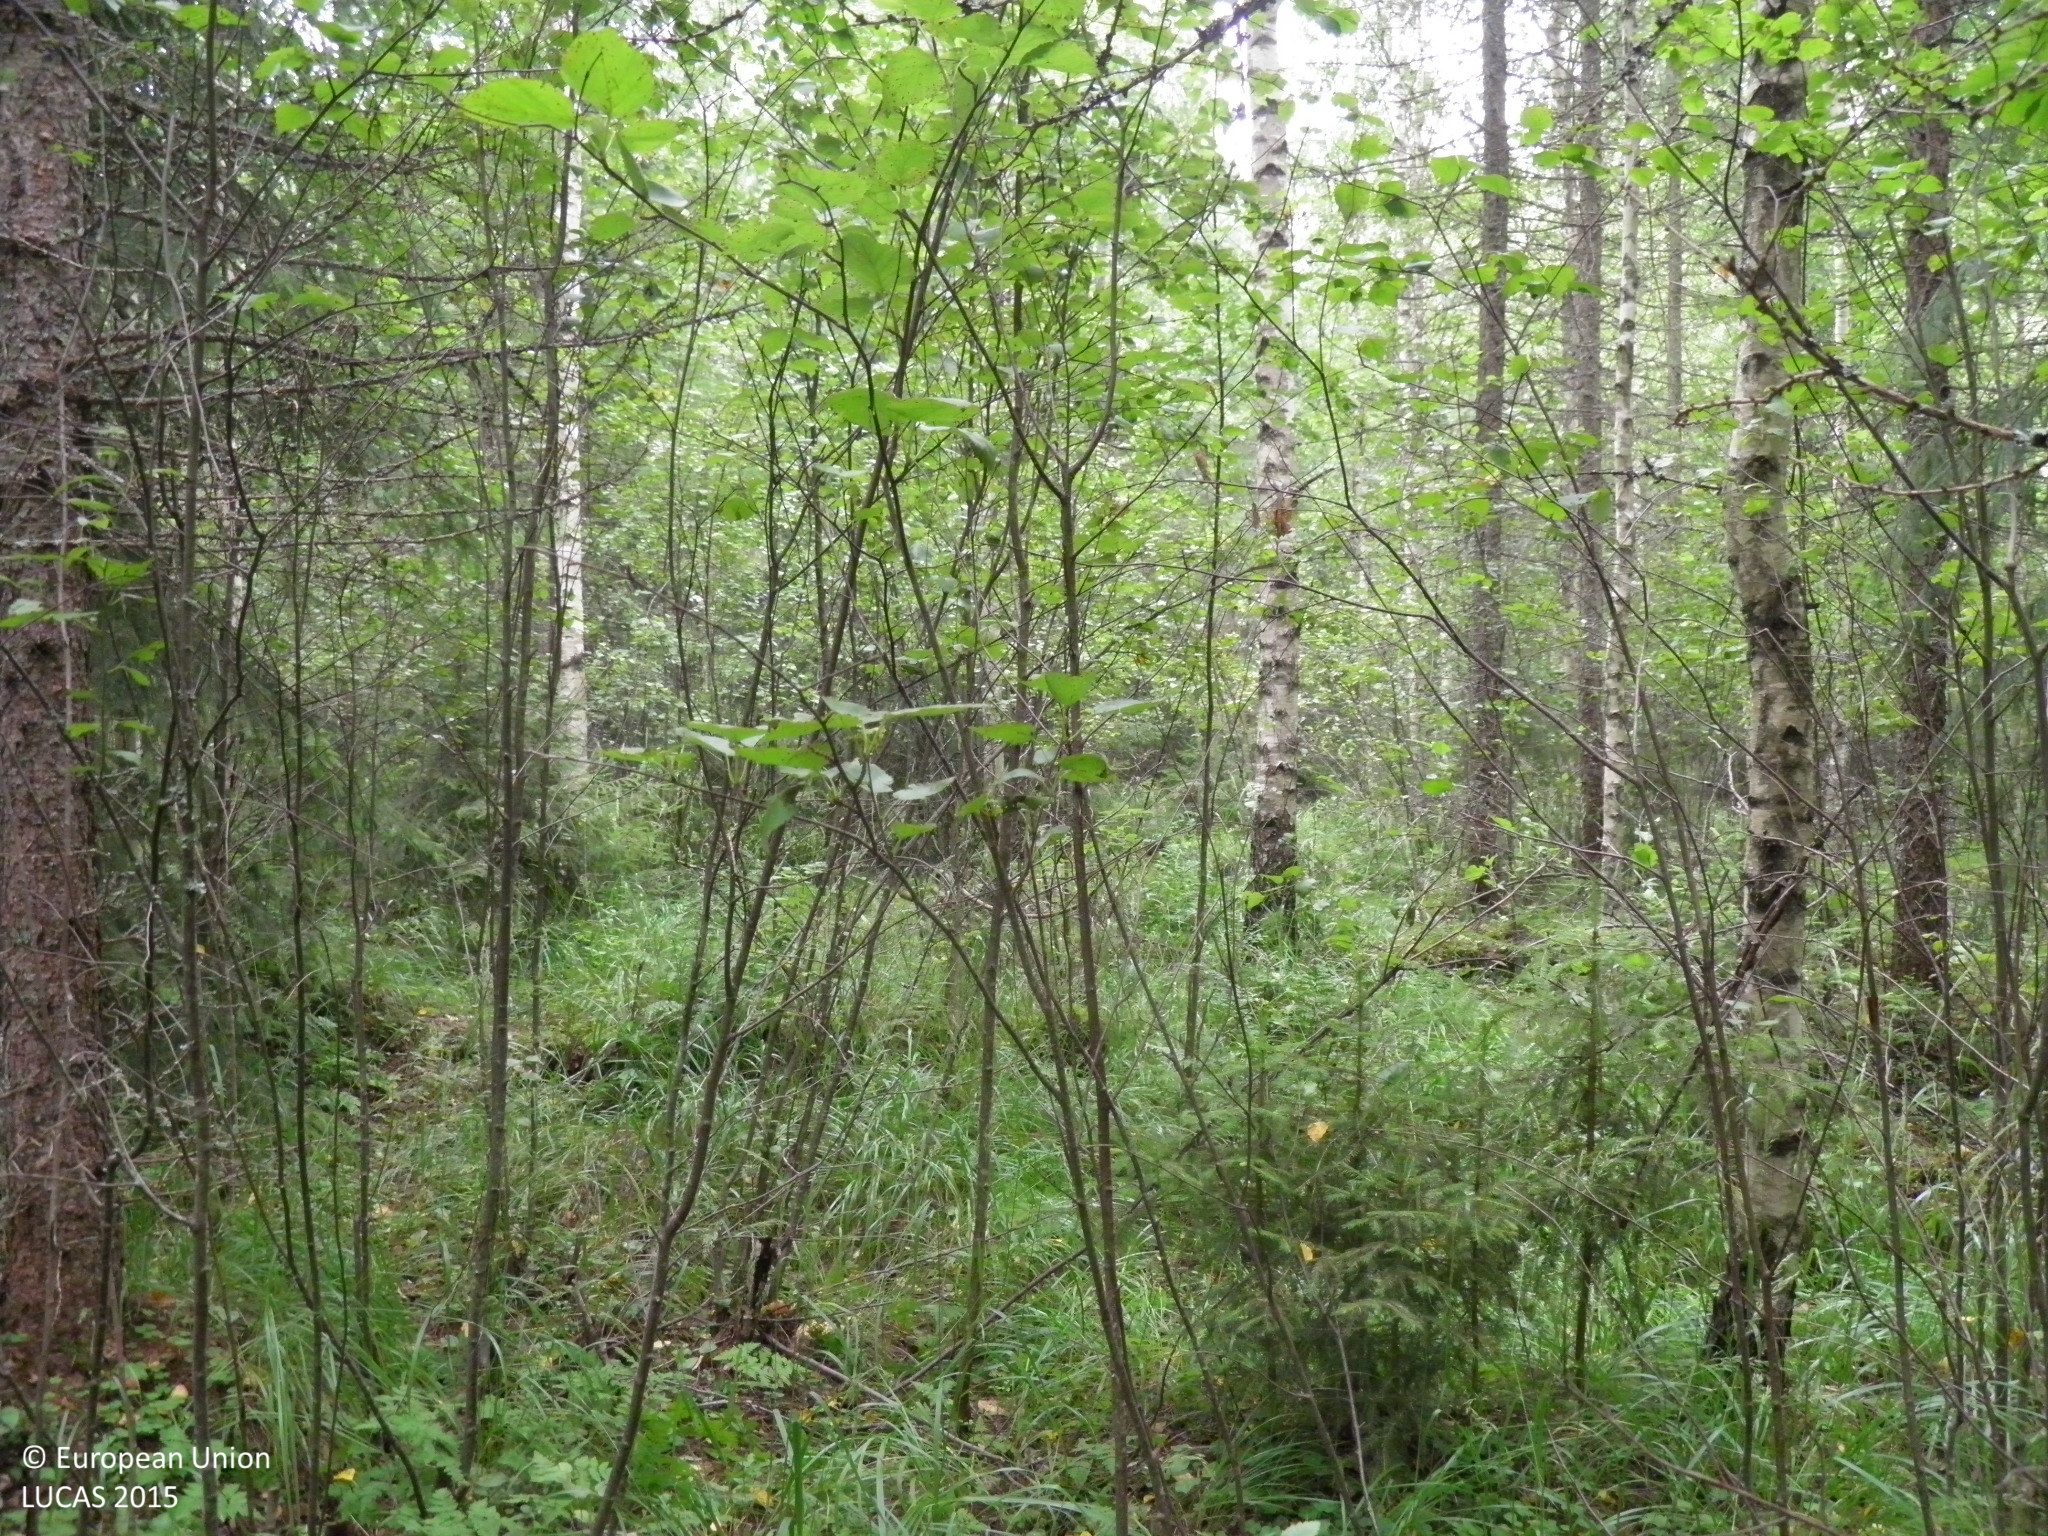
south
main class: Woodland
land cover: Pine dominated mixed woodland
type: hemiboreal forest and nemoral coniferous forest and mixed broadleaved-coniferous forest
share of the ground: > 75 %
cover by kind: broadleaved forest trees 45 %, coniferous forest trees 40 %, shrubs 5 %, herbaceous plants 5 %, lichens and mosses 5 %
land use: Forestry
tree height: > 5 m
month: July
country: FI
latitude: 60.8642
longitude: 22.9075
